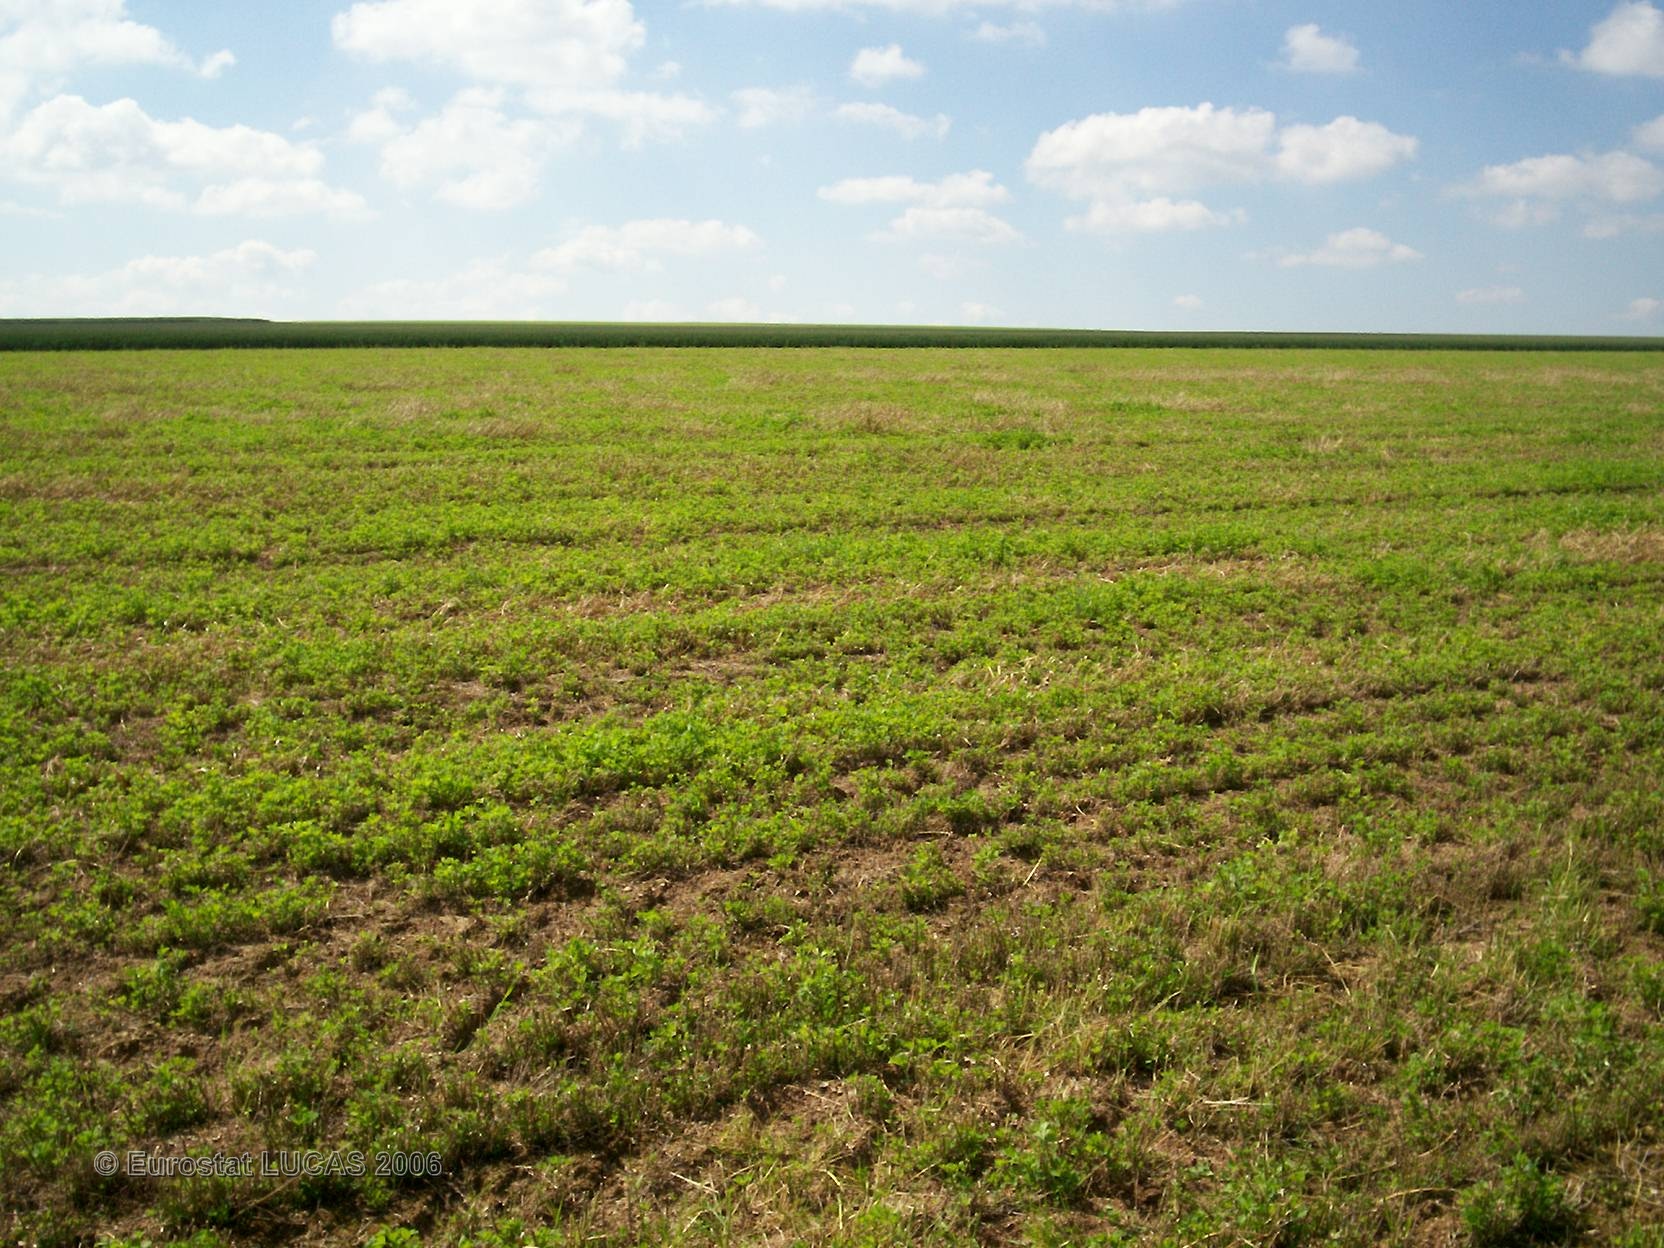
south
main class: Cropland
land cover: Common wheat
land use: Agriculture (excluding fallow land and kitchen gardens)
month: June
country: FR
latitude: 48.7888
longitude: 4.4843
